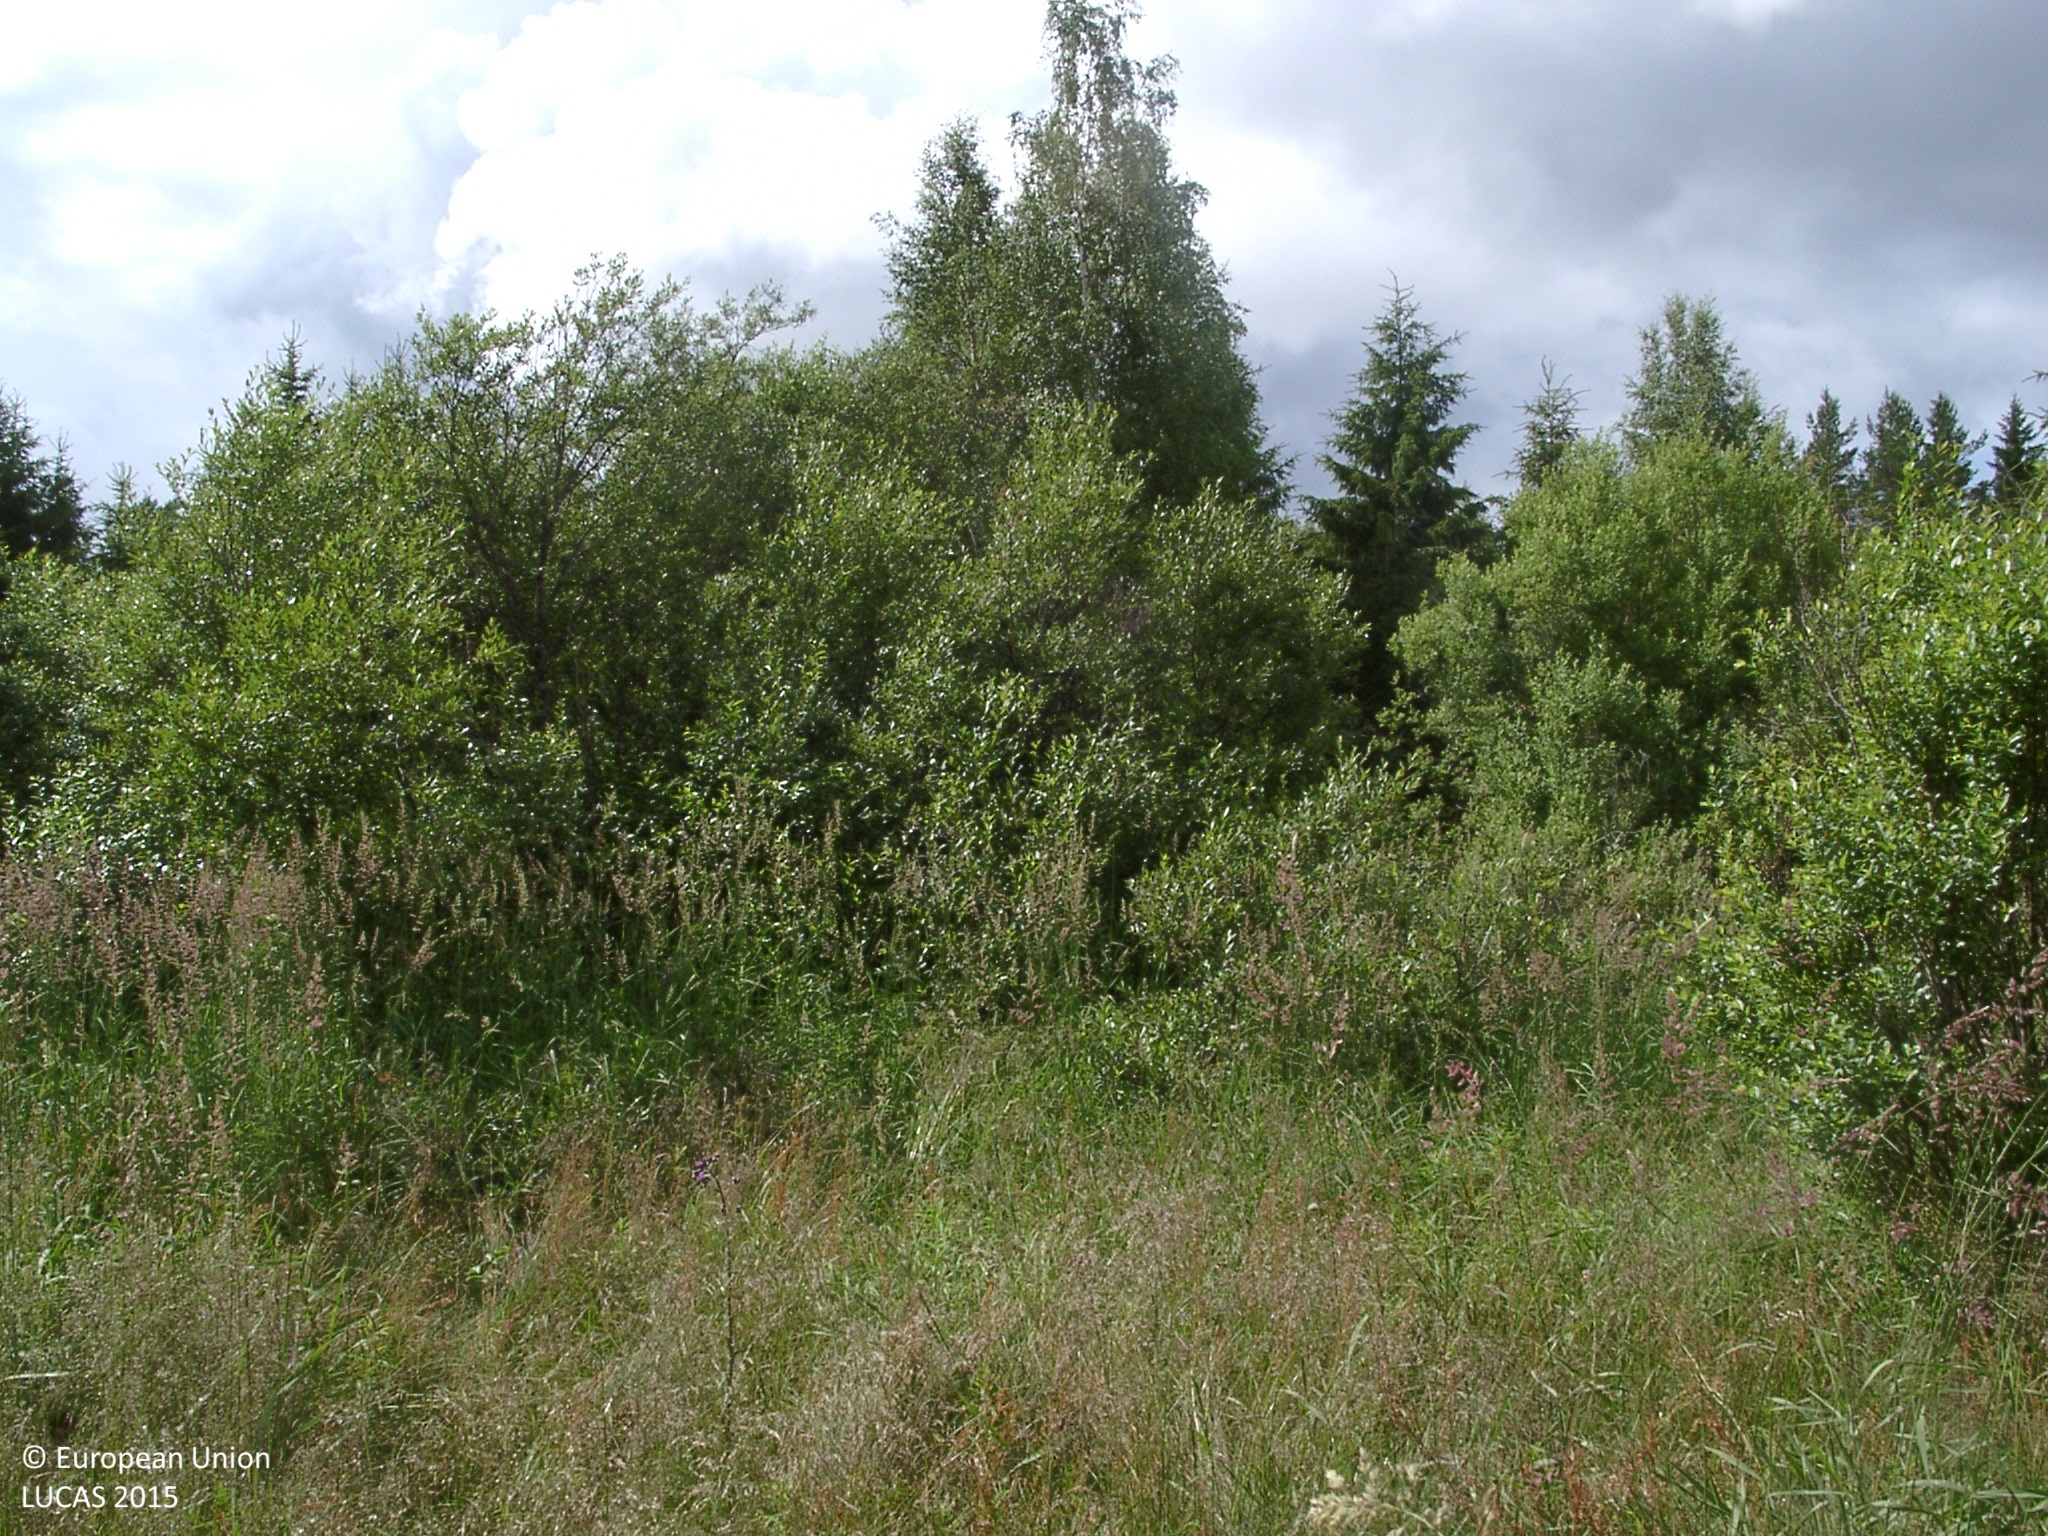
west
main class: Shrubland
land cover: Shrubland with sparse tree cover
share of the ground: 10 - 25 %
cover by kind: herbaceous plants 80 %, shrubs 15 %, broadleaved forest trees 5 %
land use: Semi-natural and natural areas not in use
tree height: < 5 m
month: July
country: FI
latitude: 61.6844
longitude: 24.8646
